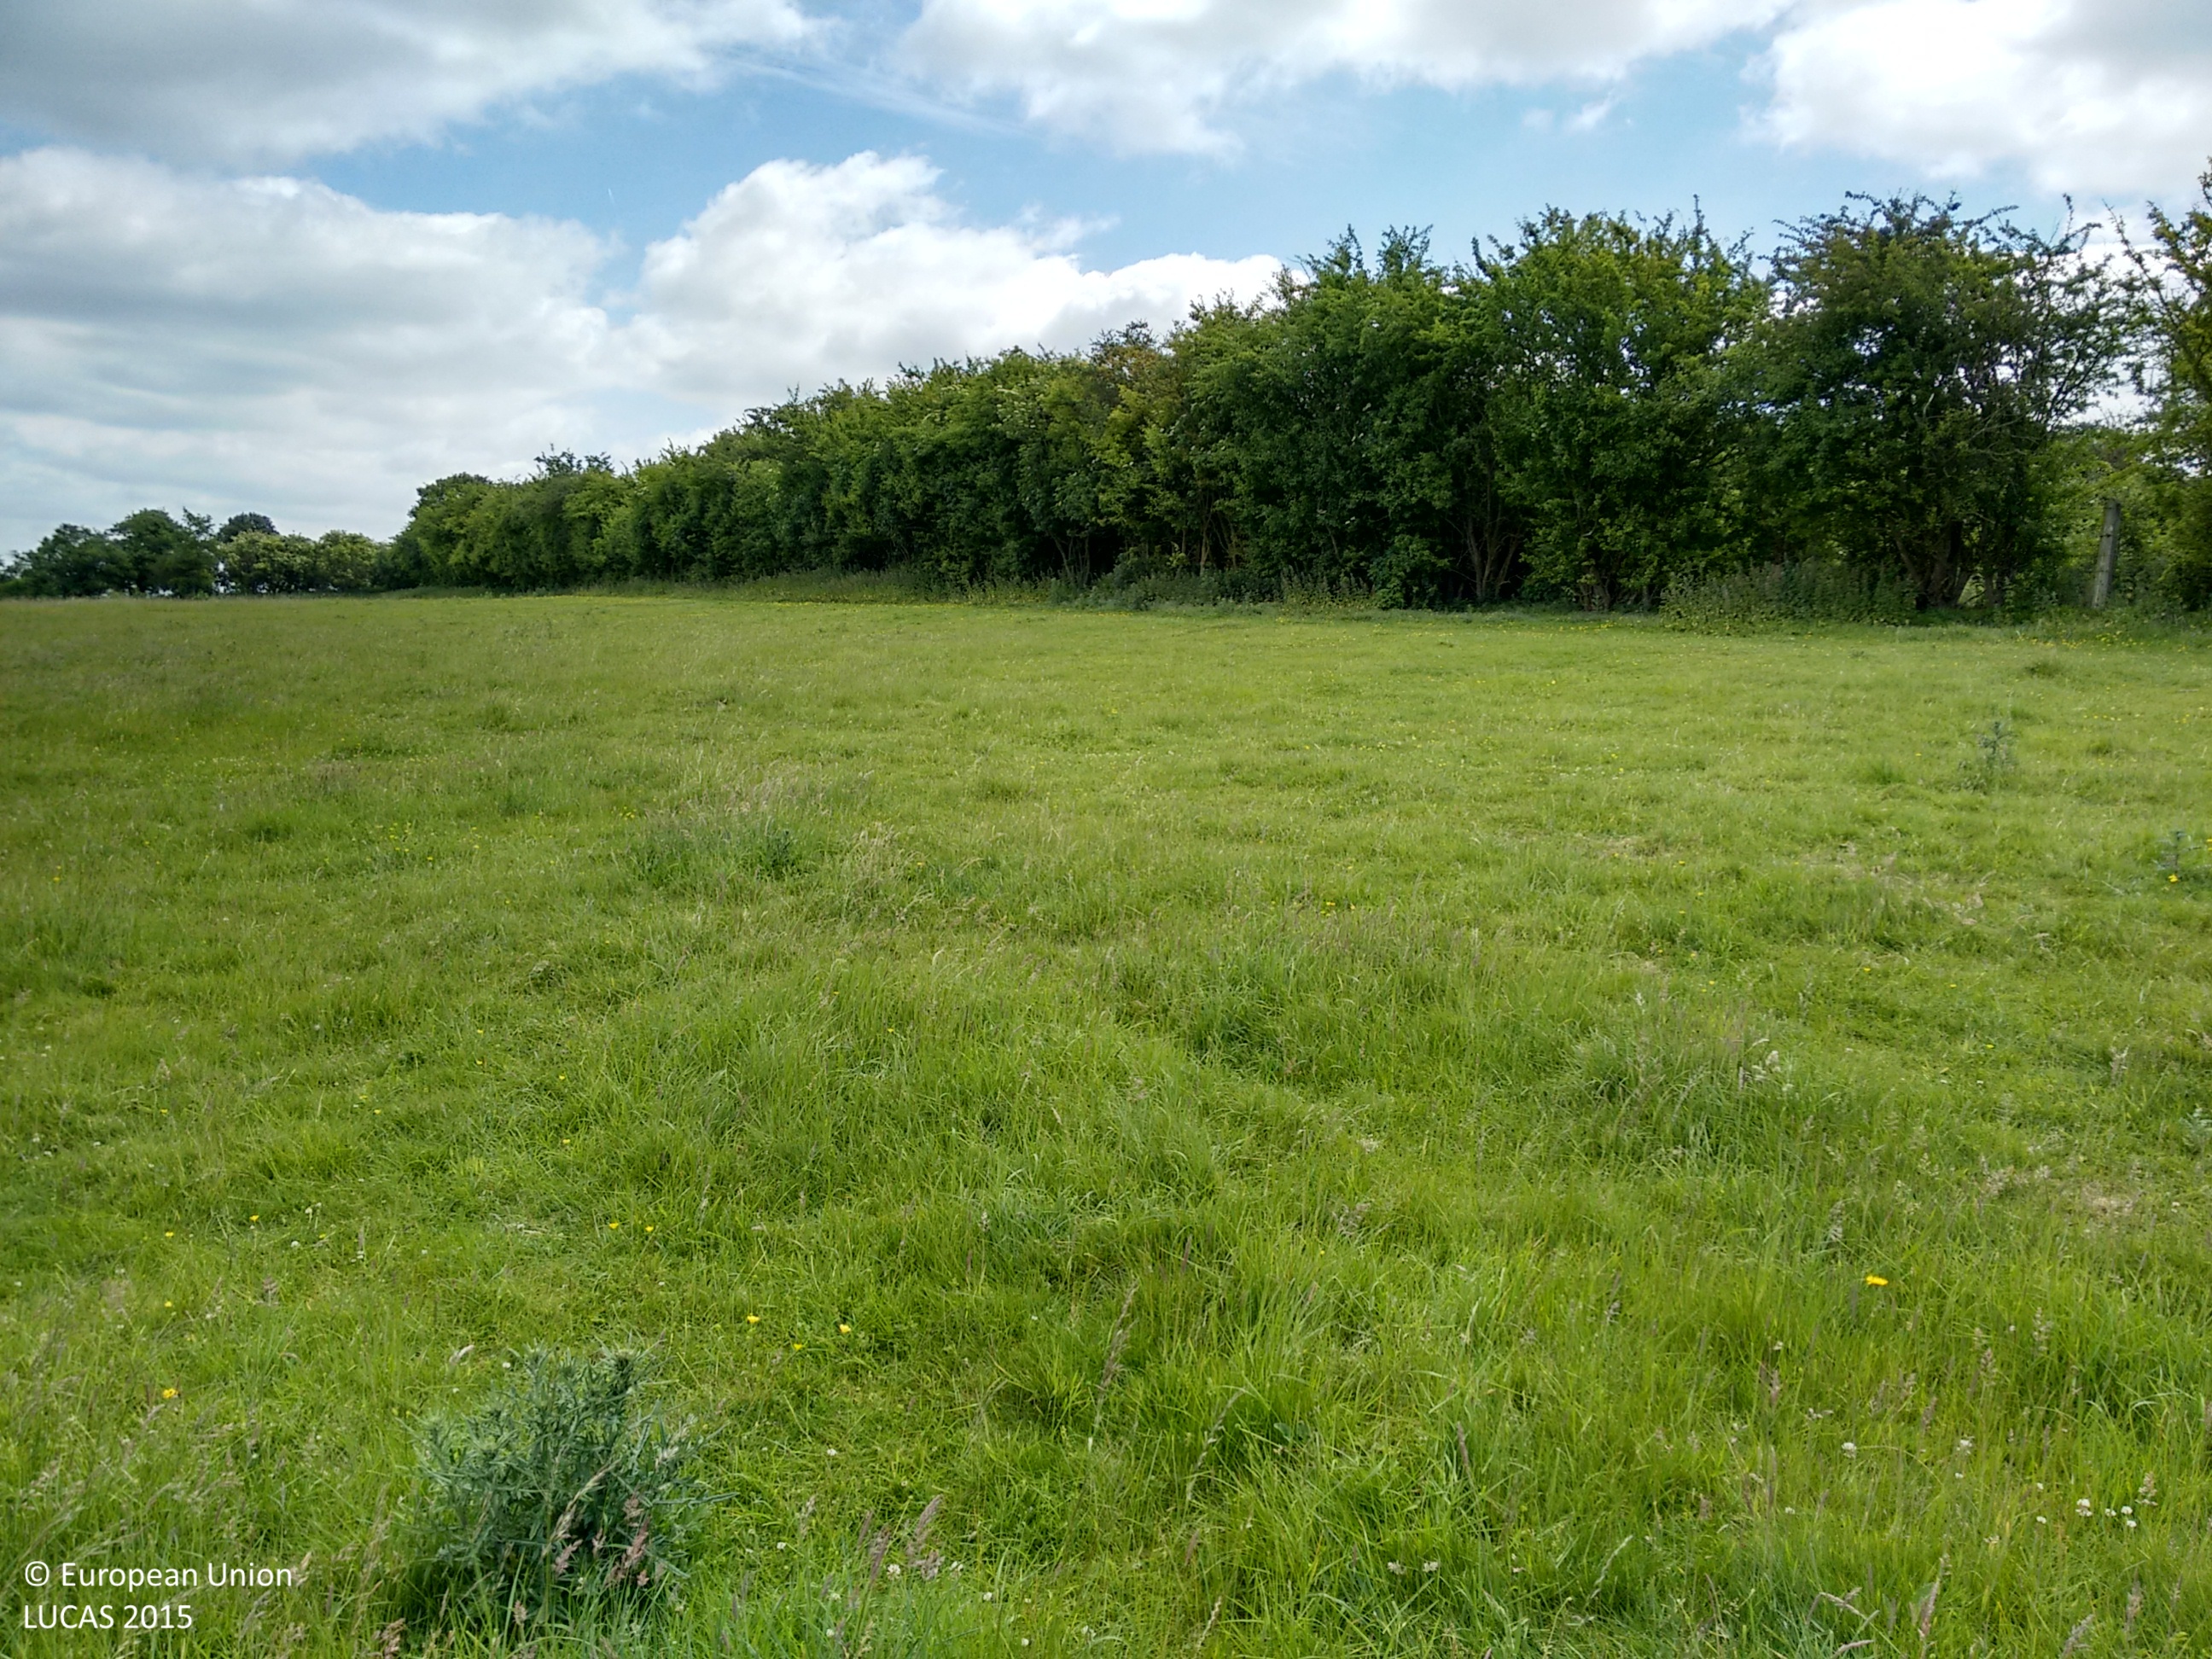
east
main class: Grassland
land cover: Grassland without tree/shrub cover
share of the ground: > 75 %
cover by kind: herbaceous plants 100 %
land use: Agriculture (excluding fallow land and kitchen gardens)
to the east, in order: Grassland without tree/shrub cover; Managed hedges; Fences; Broadleaved woodland; Railways; Broadleaved woodland; Fences; Grassland without tree/shrub cover; Fences; Broadleaved woodland
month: June
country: GB
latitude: 51.4128
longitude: -1.5398
